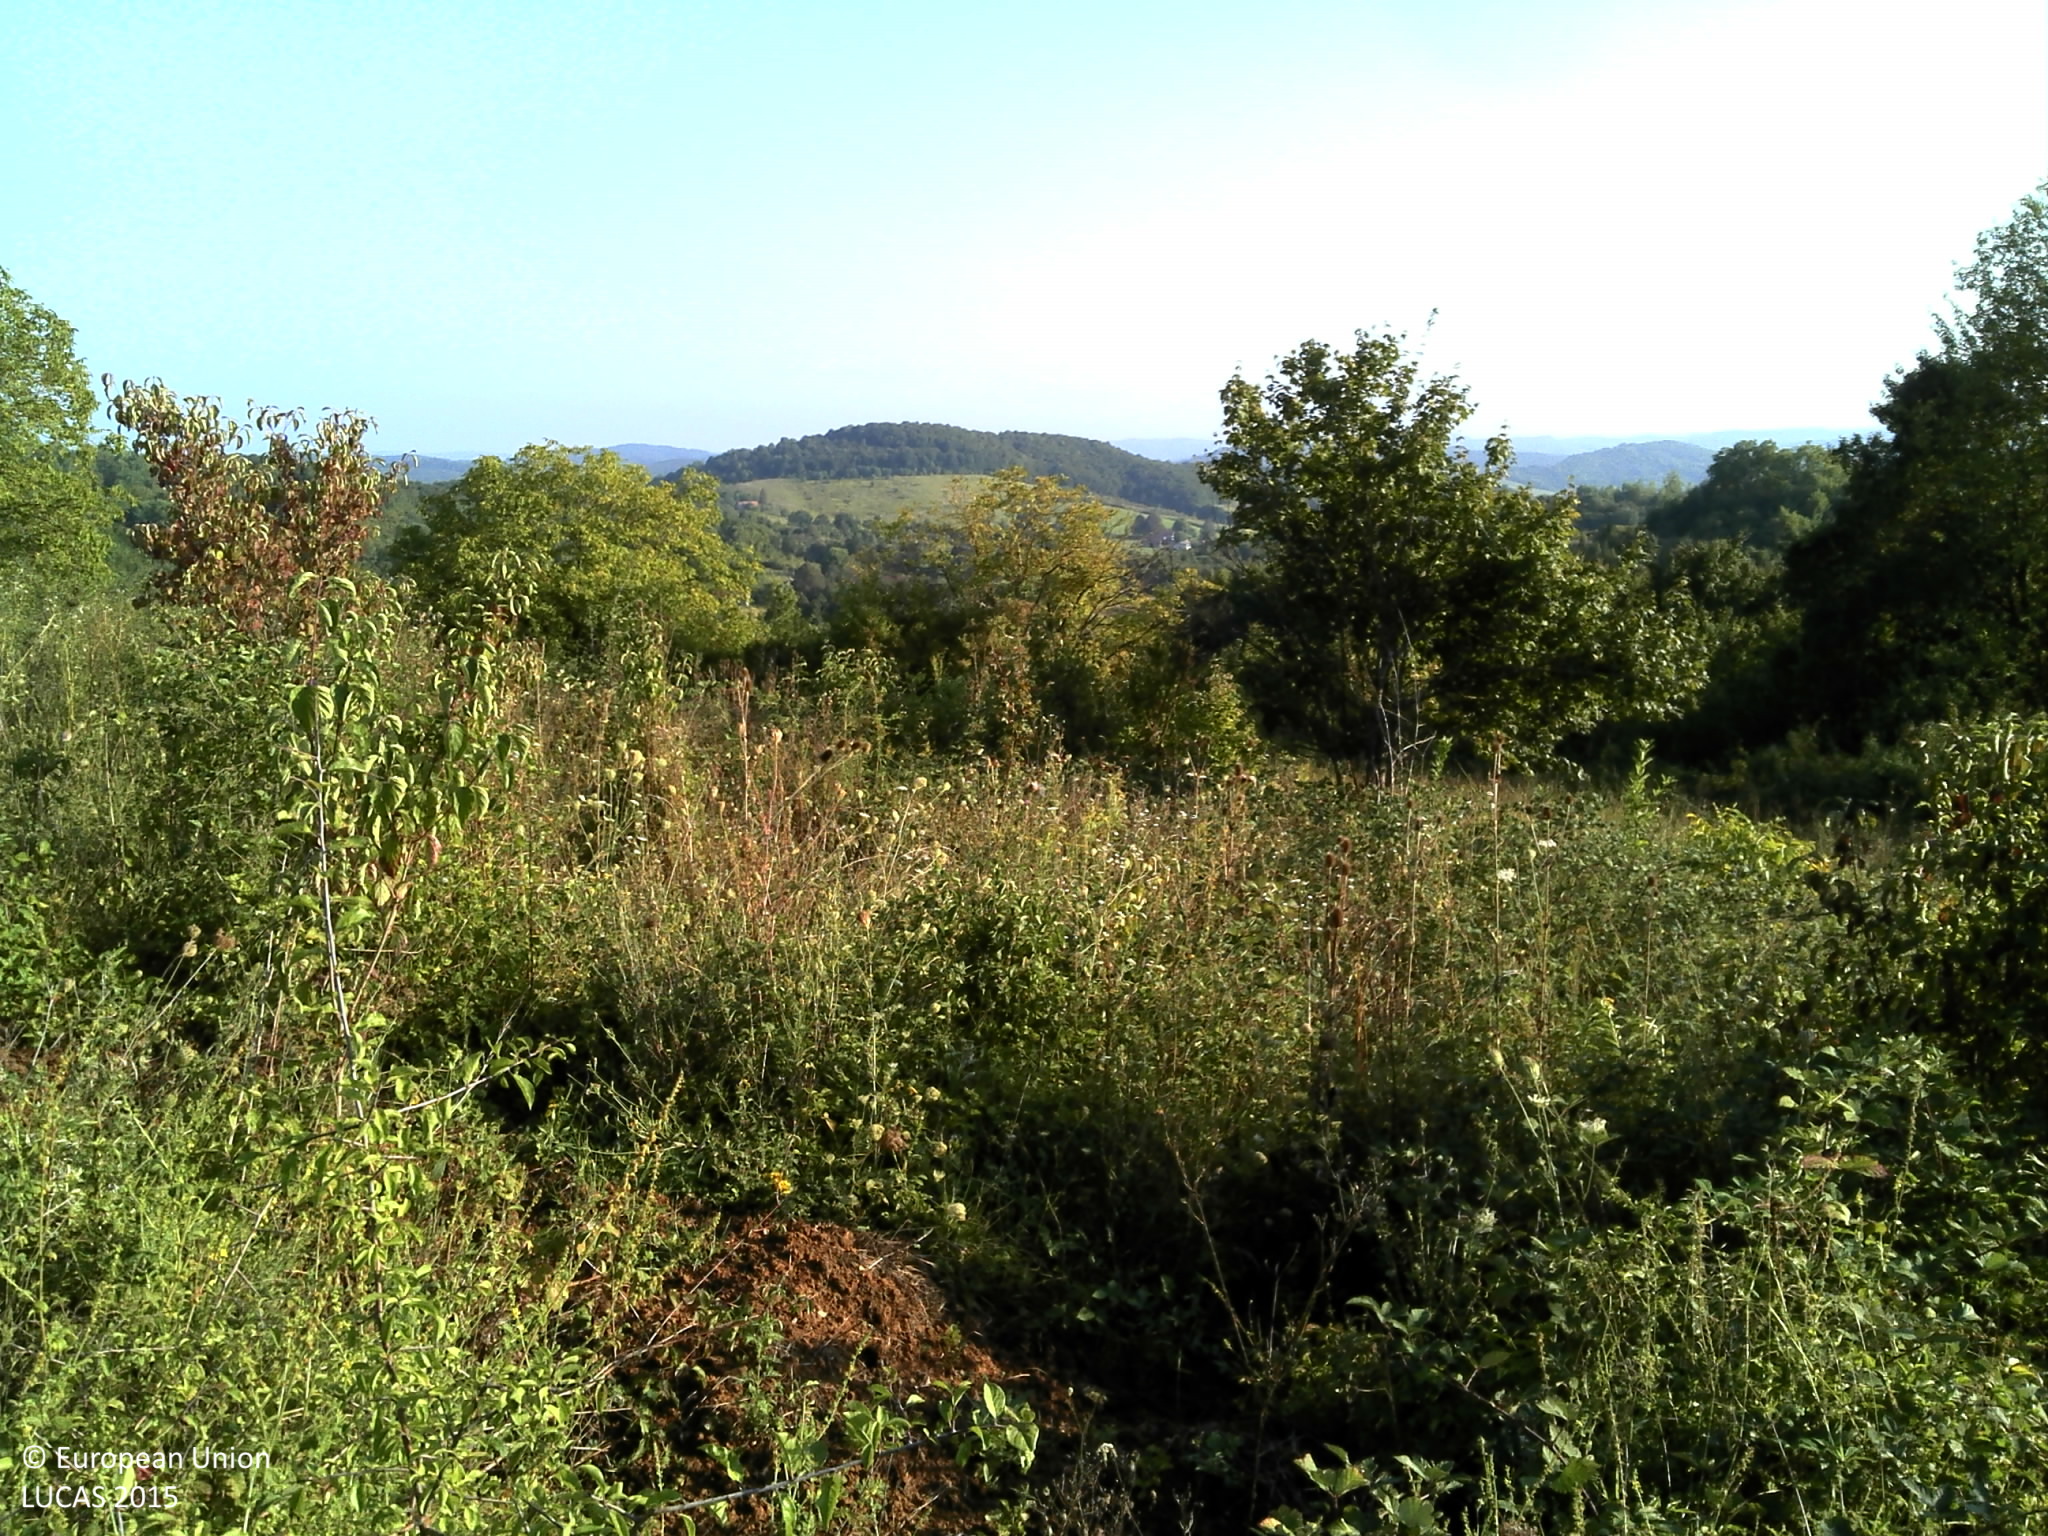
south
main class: Grassland
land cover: Grassland with sparse tree/shrub cover
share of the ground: > 75 %
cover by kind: herbaceous plants 85 %, shrubs 10 %, broadleaved forest trees 5 %
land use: Semi-natural and natural areas not in use
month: August
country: HR
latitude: 45.2412
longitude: 15.7158
